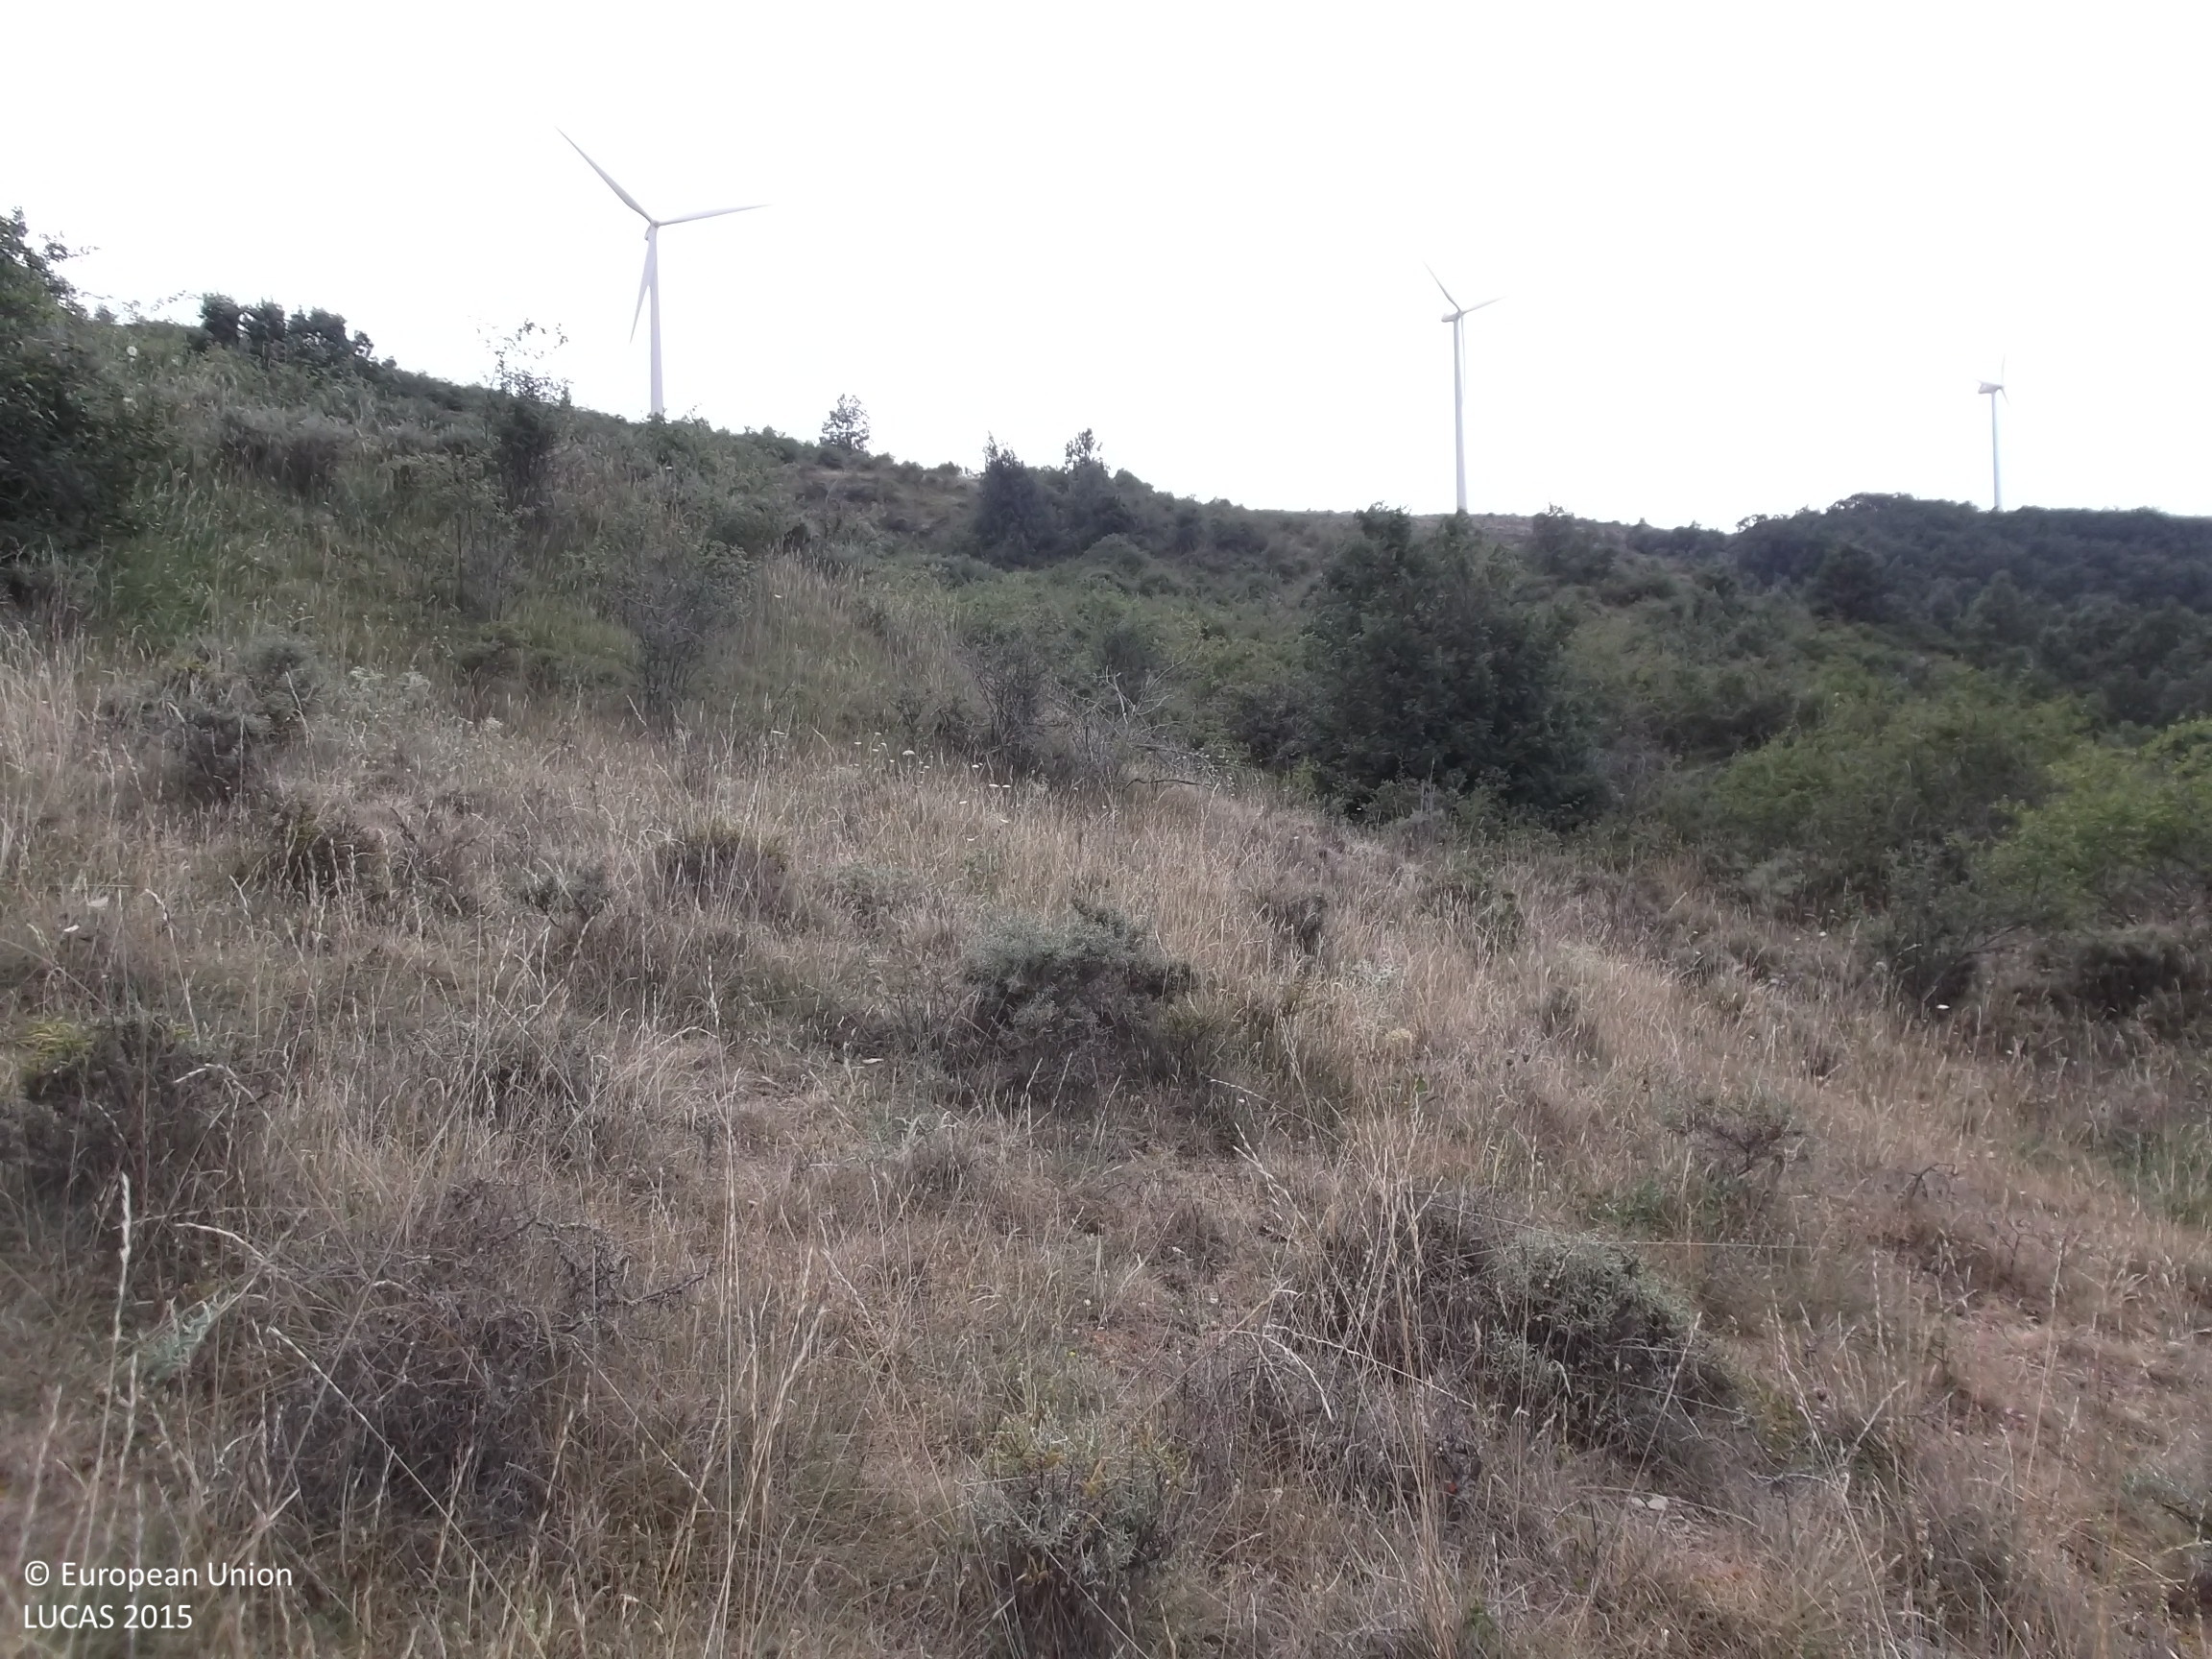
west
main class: Shrubland
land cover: Shrubland without tree cover
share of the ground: 25 - 50 %
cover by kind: shrubs 45 %, herbaceous plants 40 %, unconsolidated bare surface 10 %
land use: Abandoned areas
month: July
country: ES
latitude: 41.9817
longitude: -2.2397
